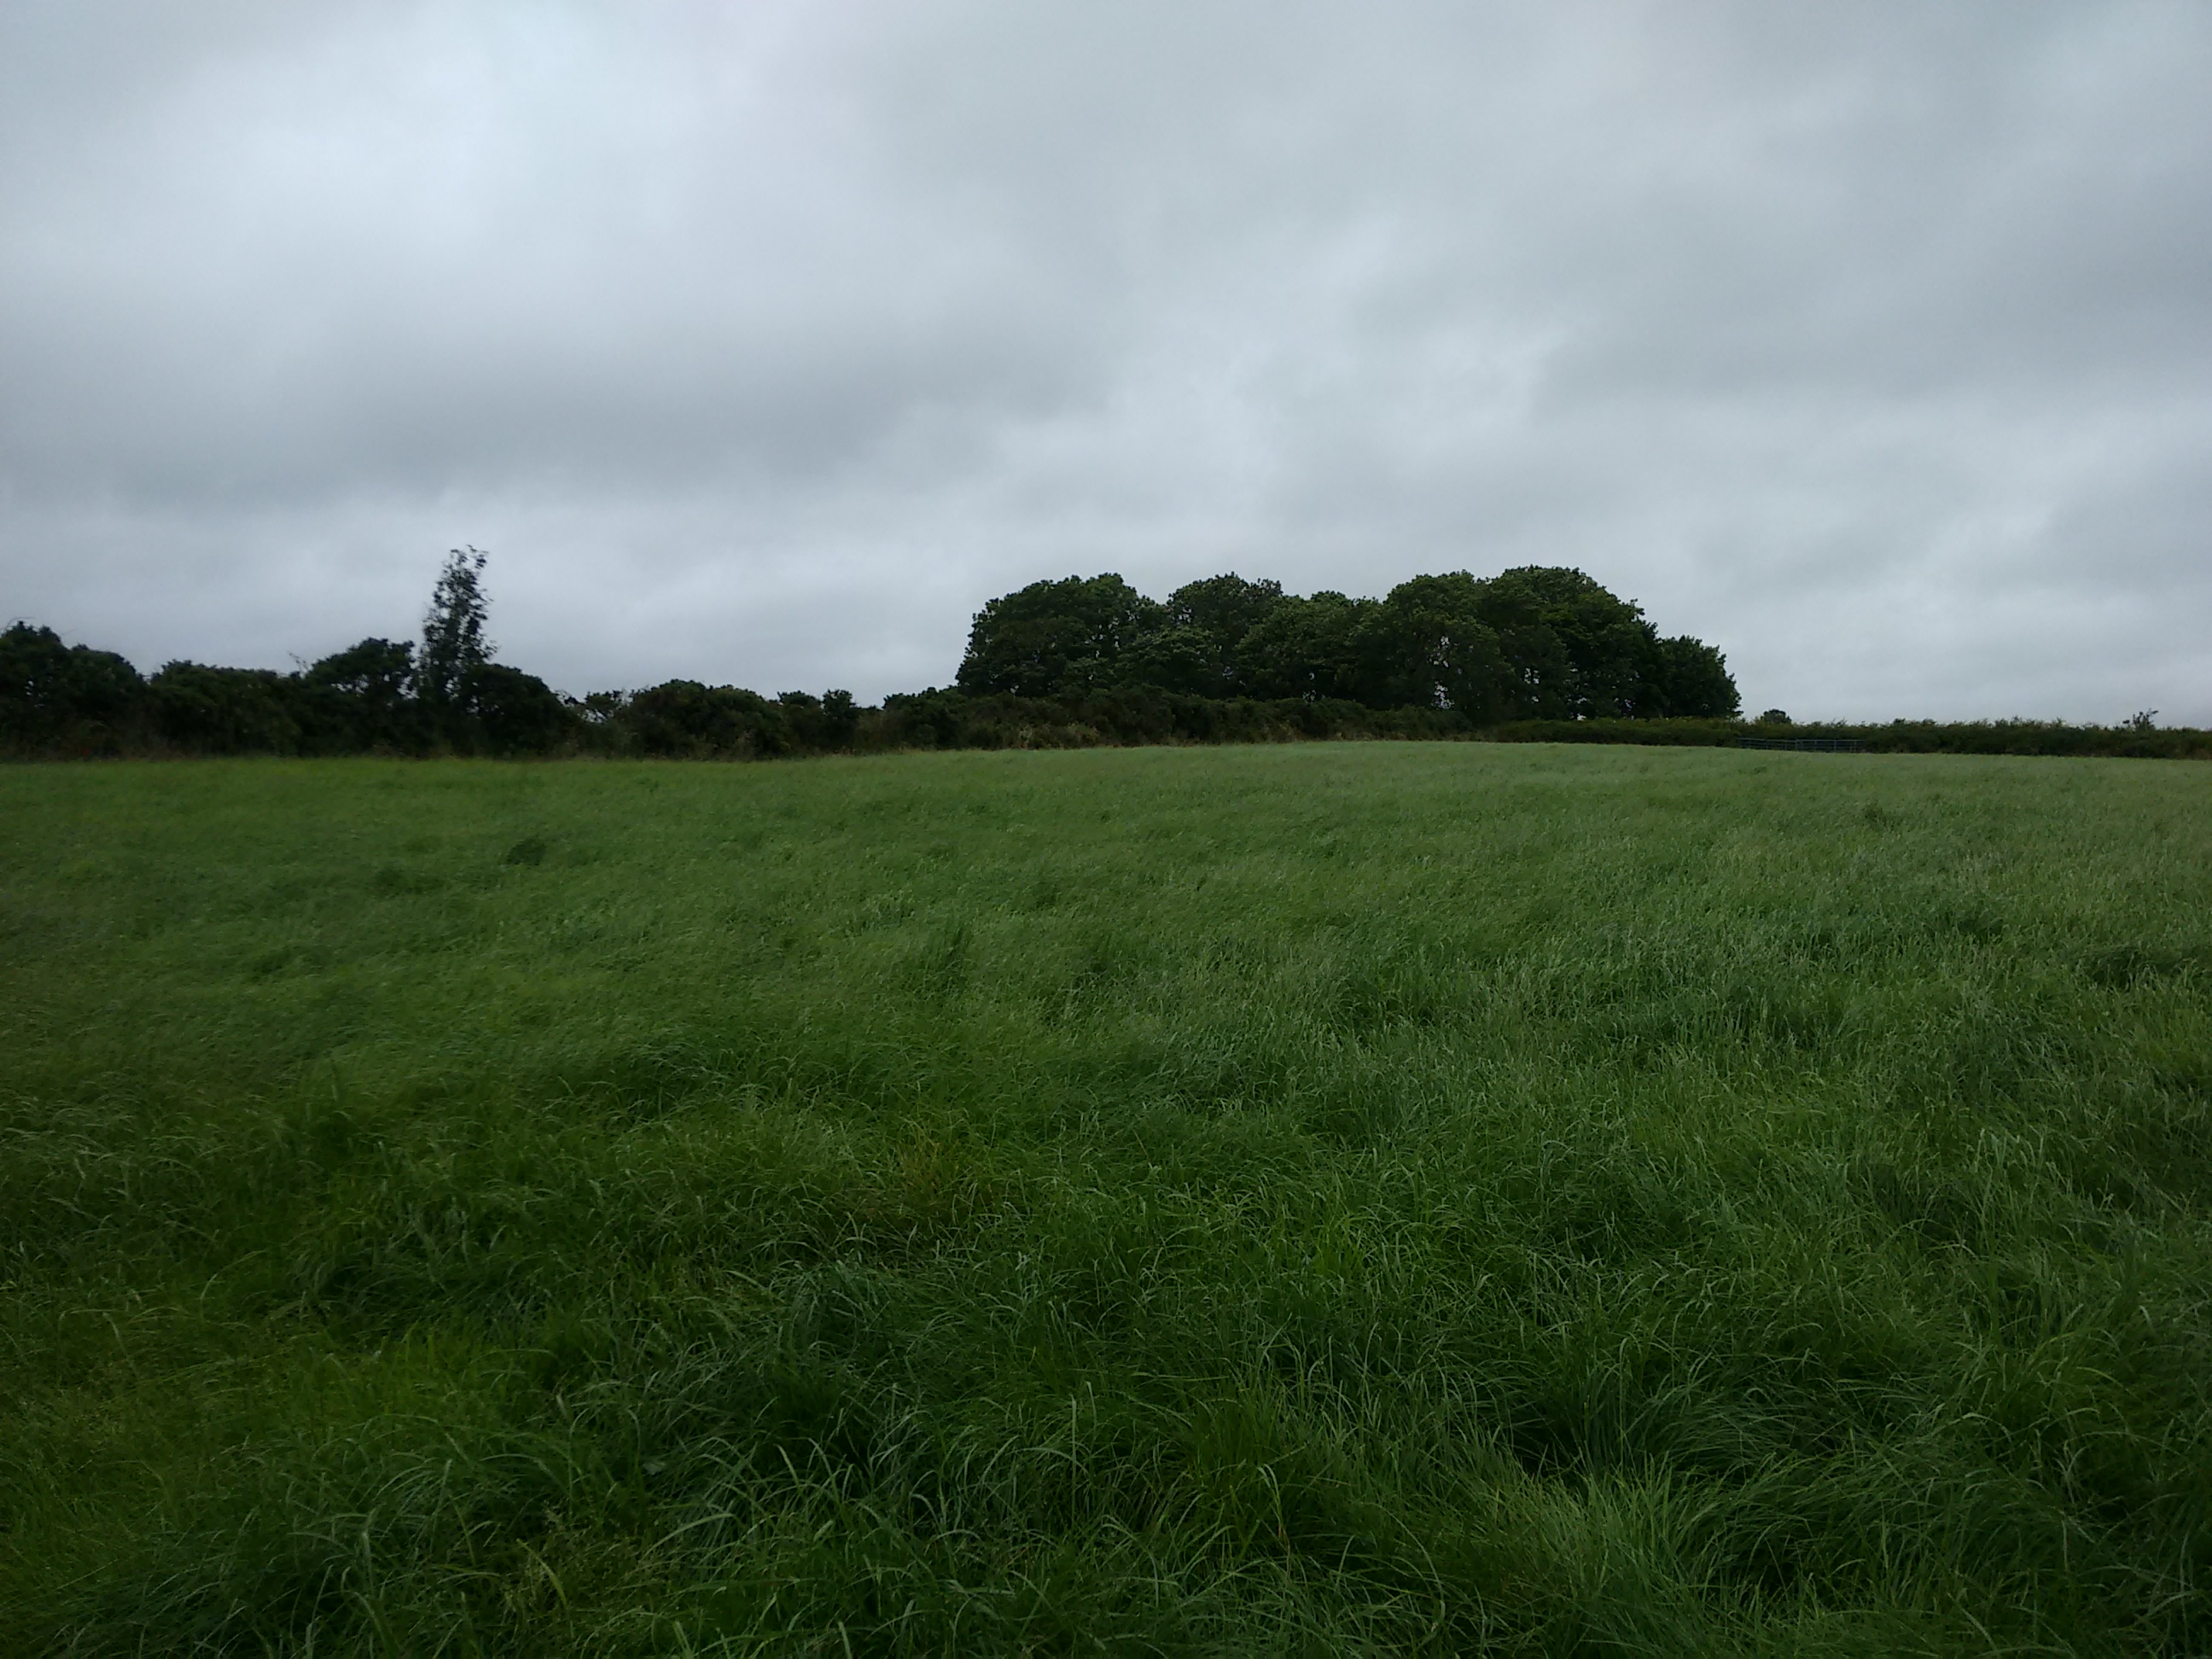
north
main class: Grassland
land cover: Grassland without tree/shrub cover
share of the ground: > 75 %
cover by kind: herbaceous plants 100 %
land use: Agriculture (excluding fallow land and kitchen gardens)
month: August
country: GB
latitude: 54.6115
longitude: -6.9050
